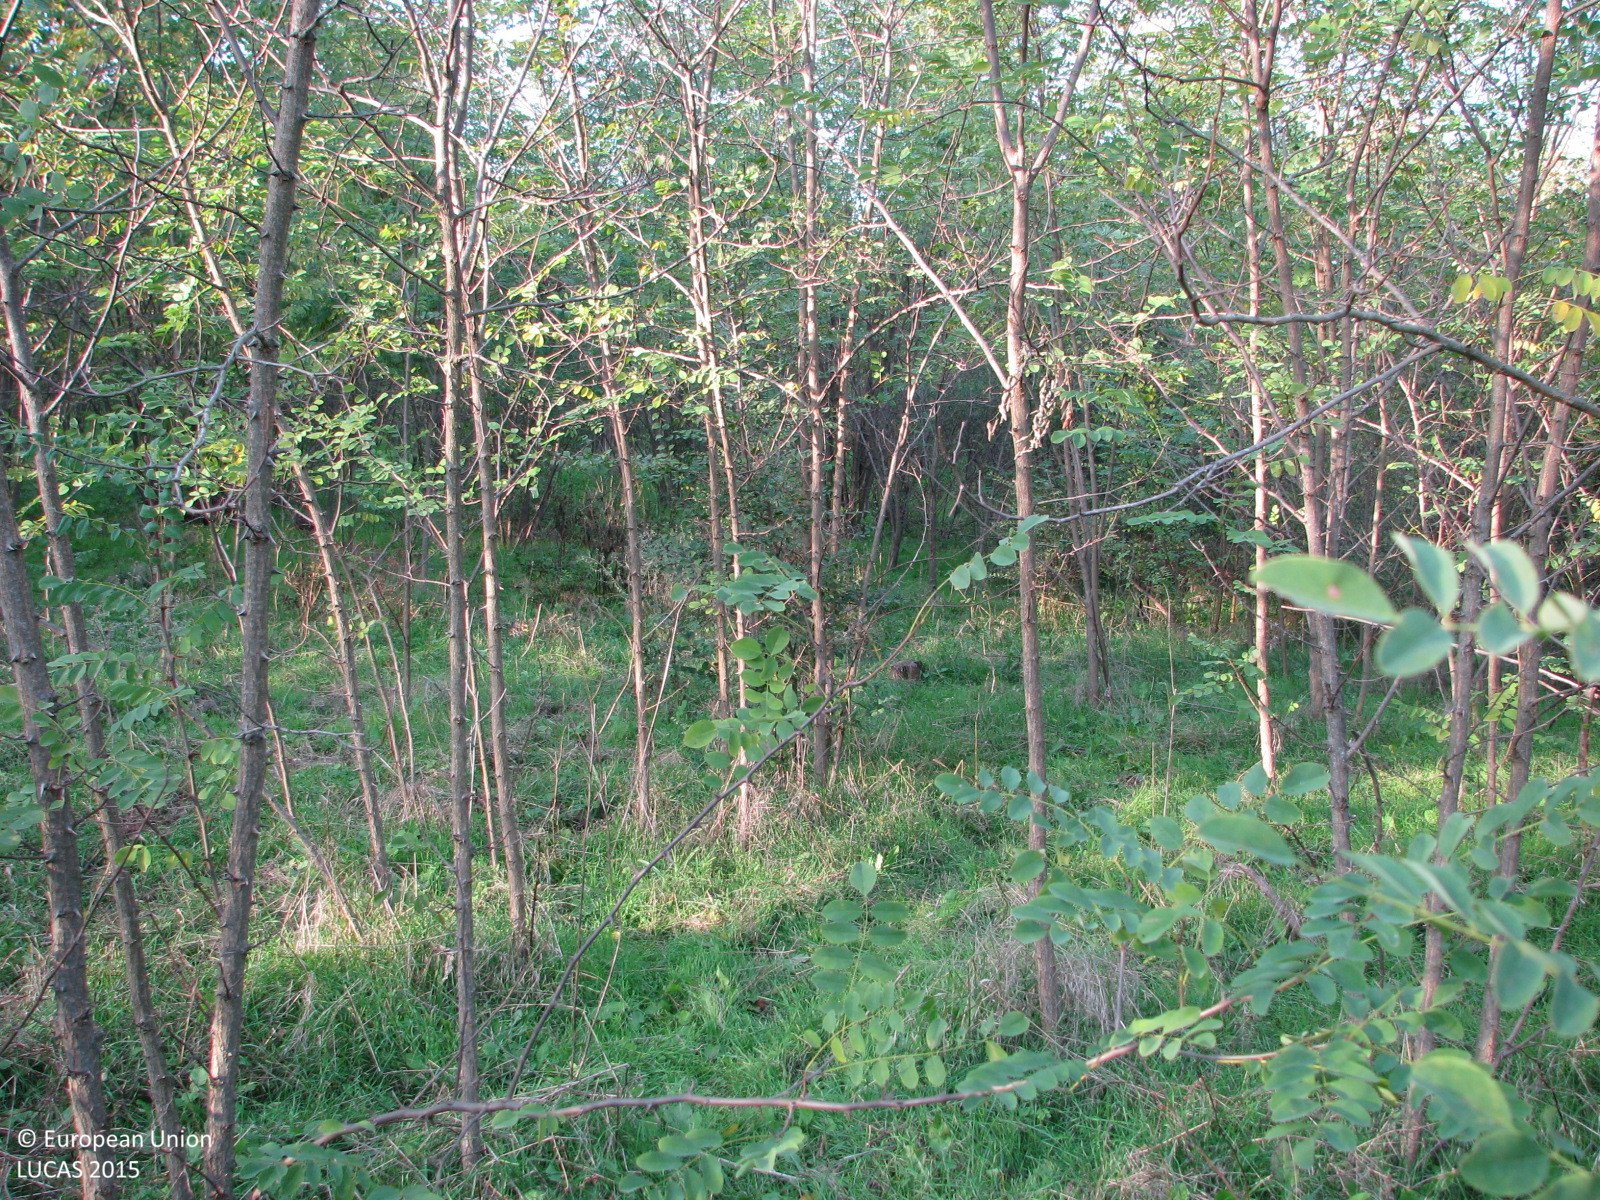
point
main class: Woodland
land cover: Broadleaved woodland
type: thermophilous deciduous forest
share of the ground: 50 - 75 %
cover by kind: broadleaved forest trees 70 %, herbaceous plants 20 %, shrubs 10 %
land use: Semi-natural and natural areas not in use
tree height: < 5 m
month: October
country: BG
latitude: 42.2440
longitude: 26.7342
